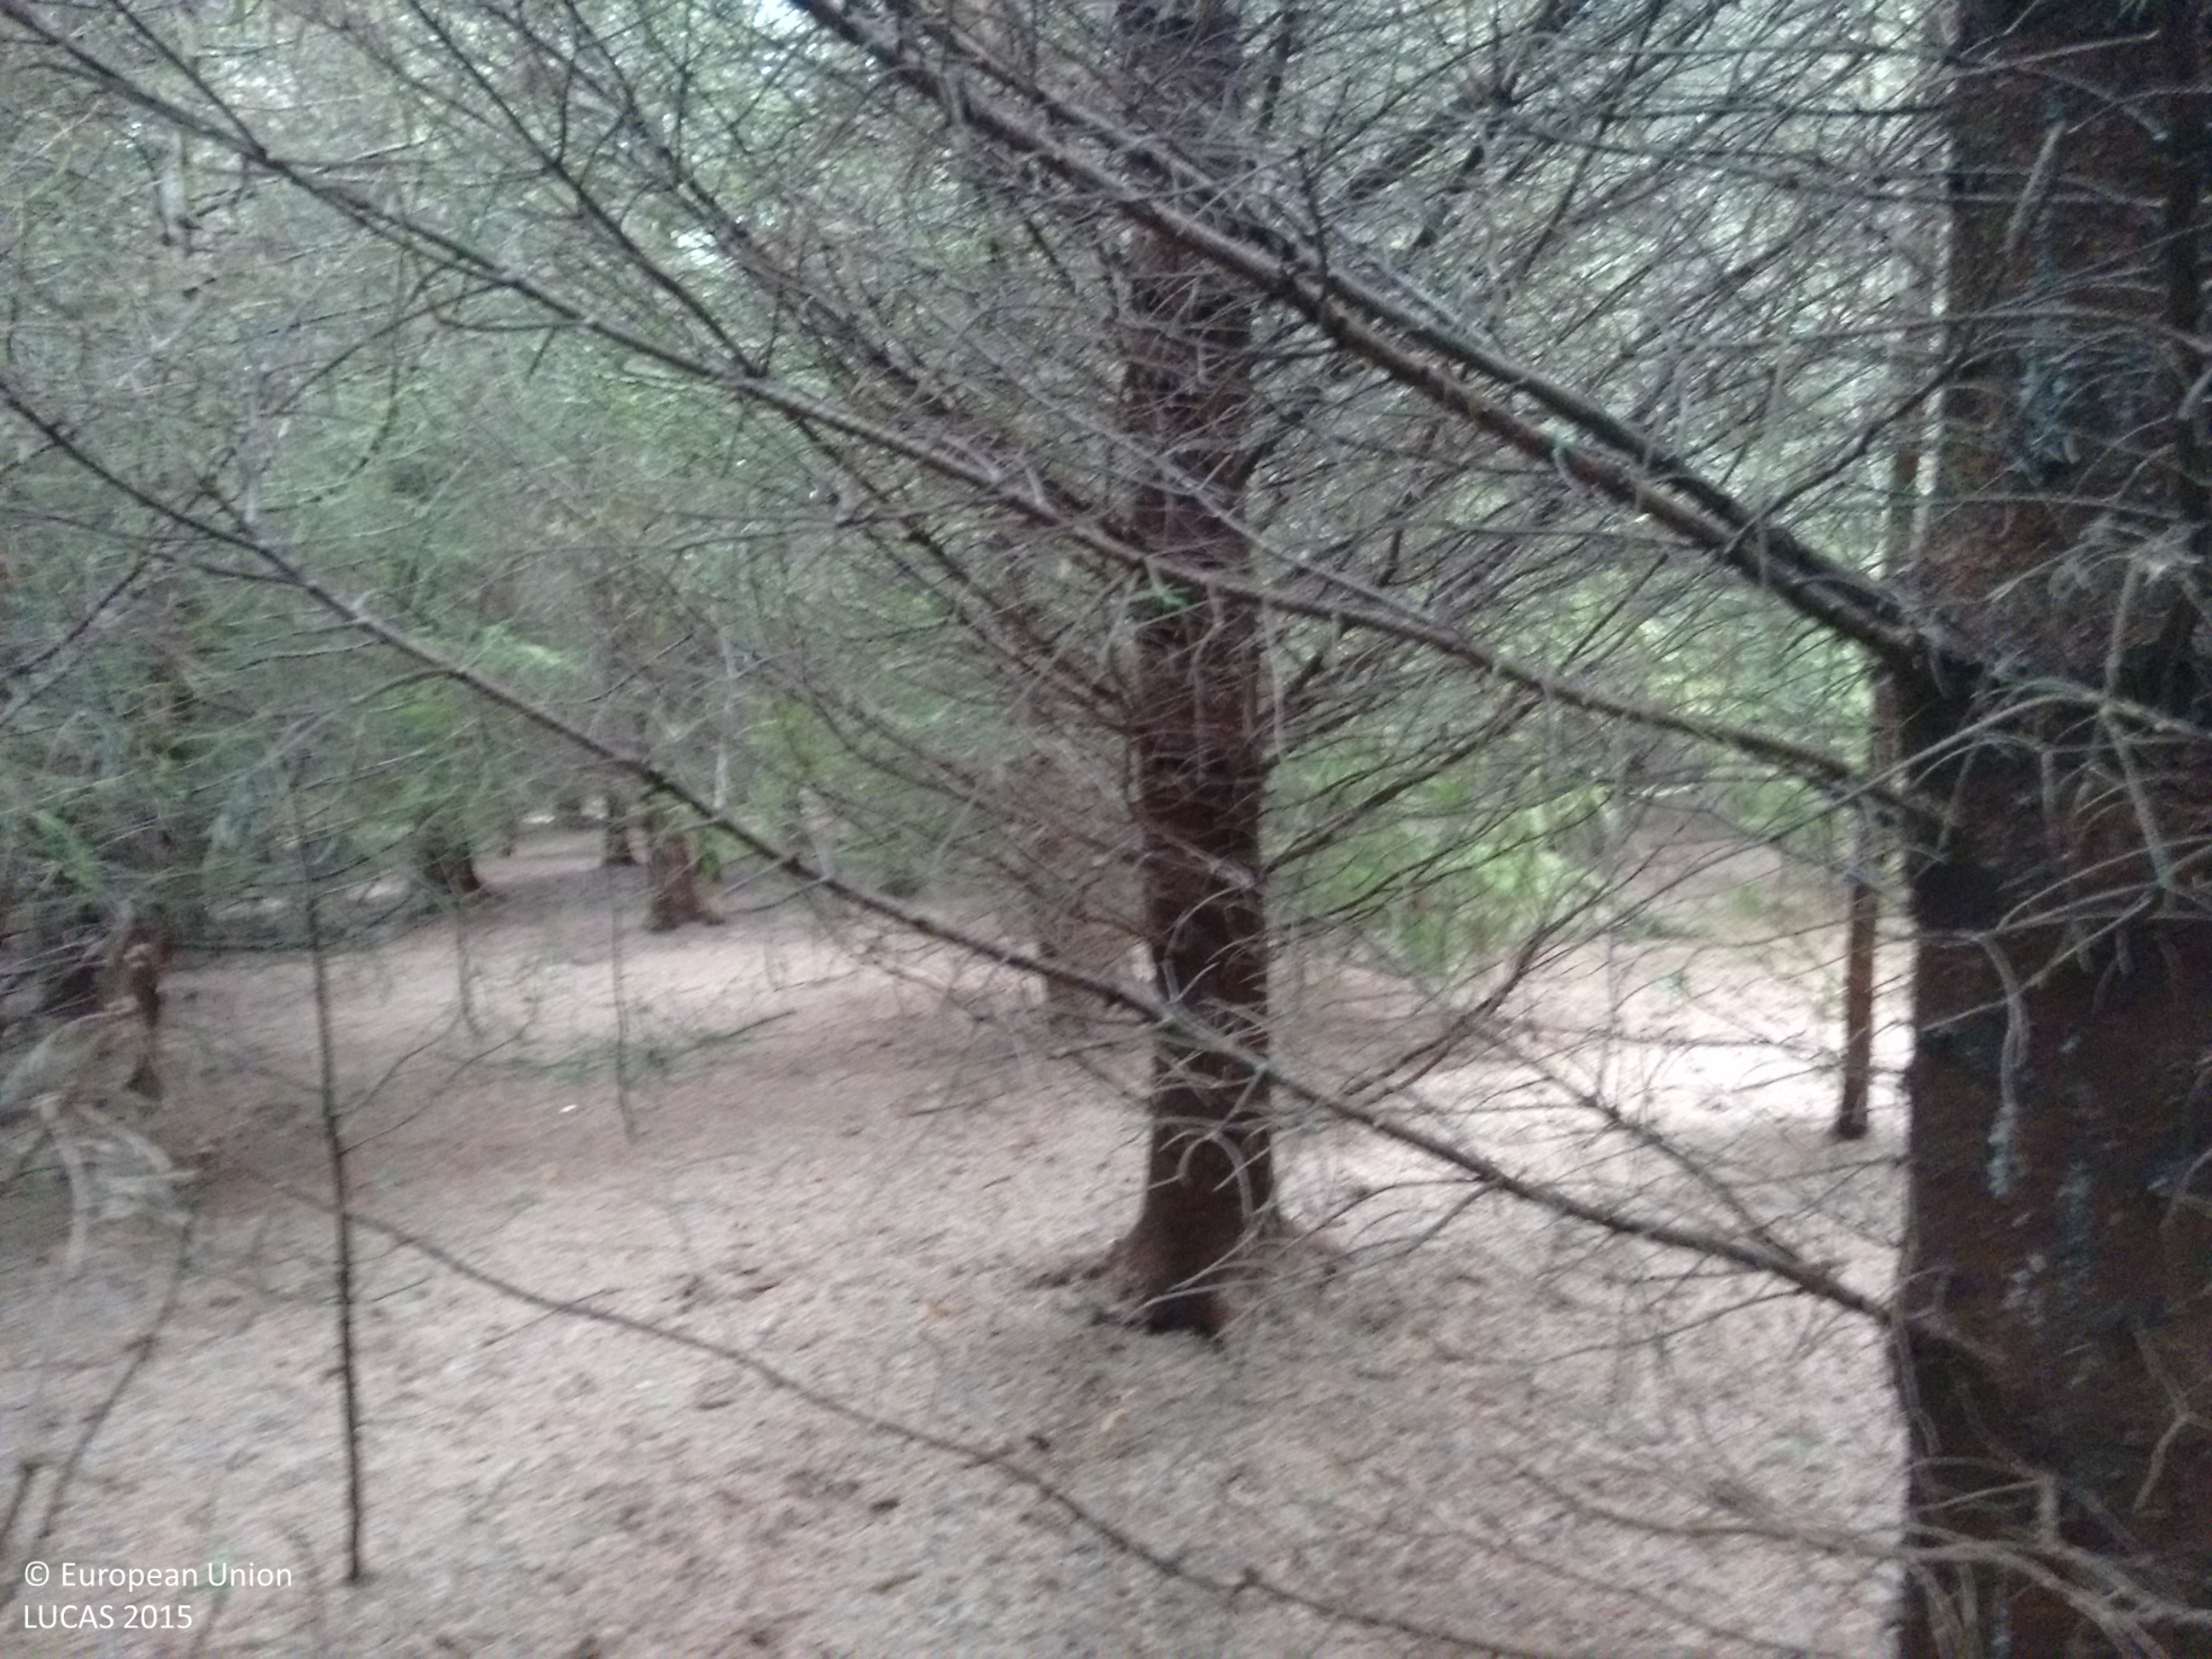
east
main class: Woodland
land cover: Spruce dominated coniferous woodland
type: exotic forest
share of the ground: > 75 %
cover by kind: coniferous forest trees 100 %
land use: Forestry
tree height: > 5 m
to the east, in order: Spruce dominated coniferous woodland
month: June
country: IE
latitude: 52.0310
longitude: -8.0327
